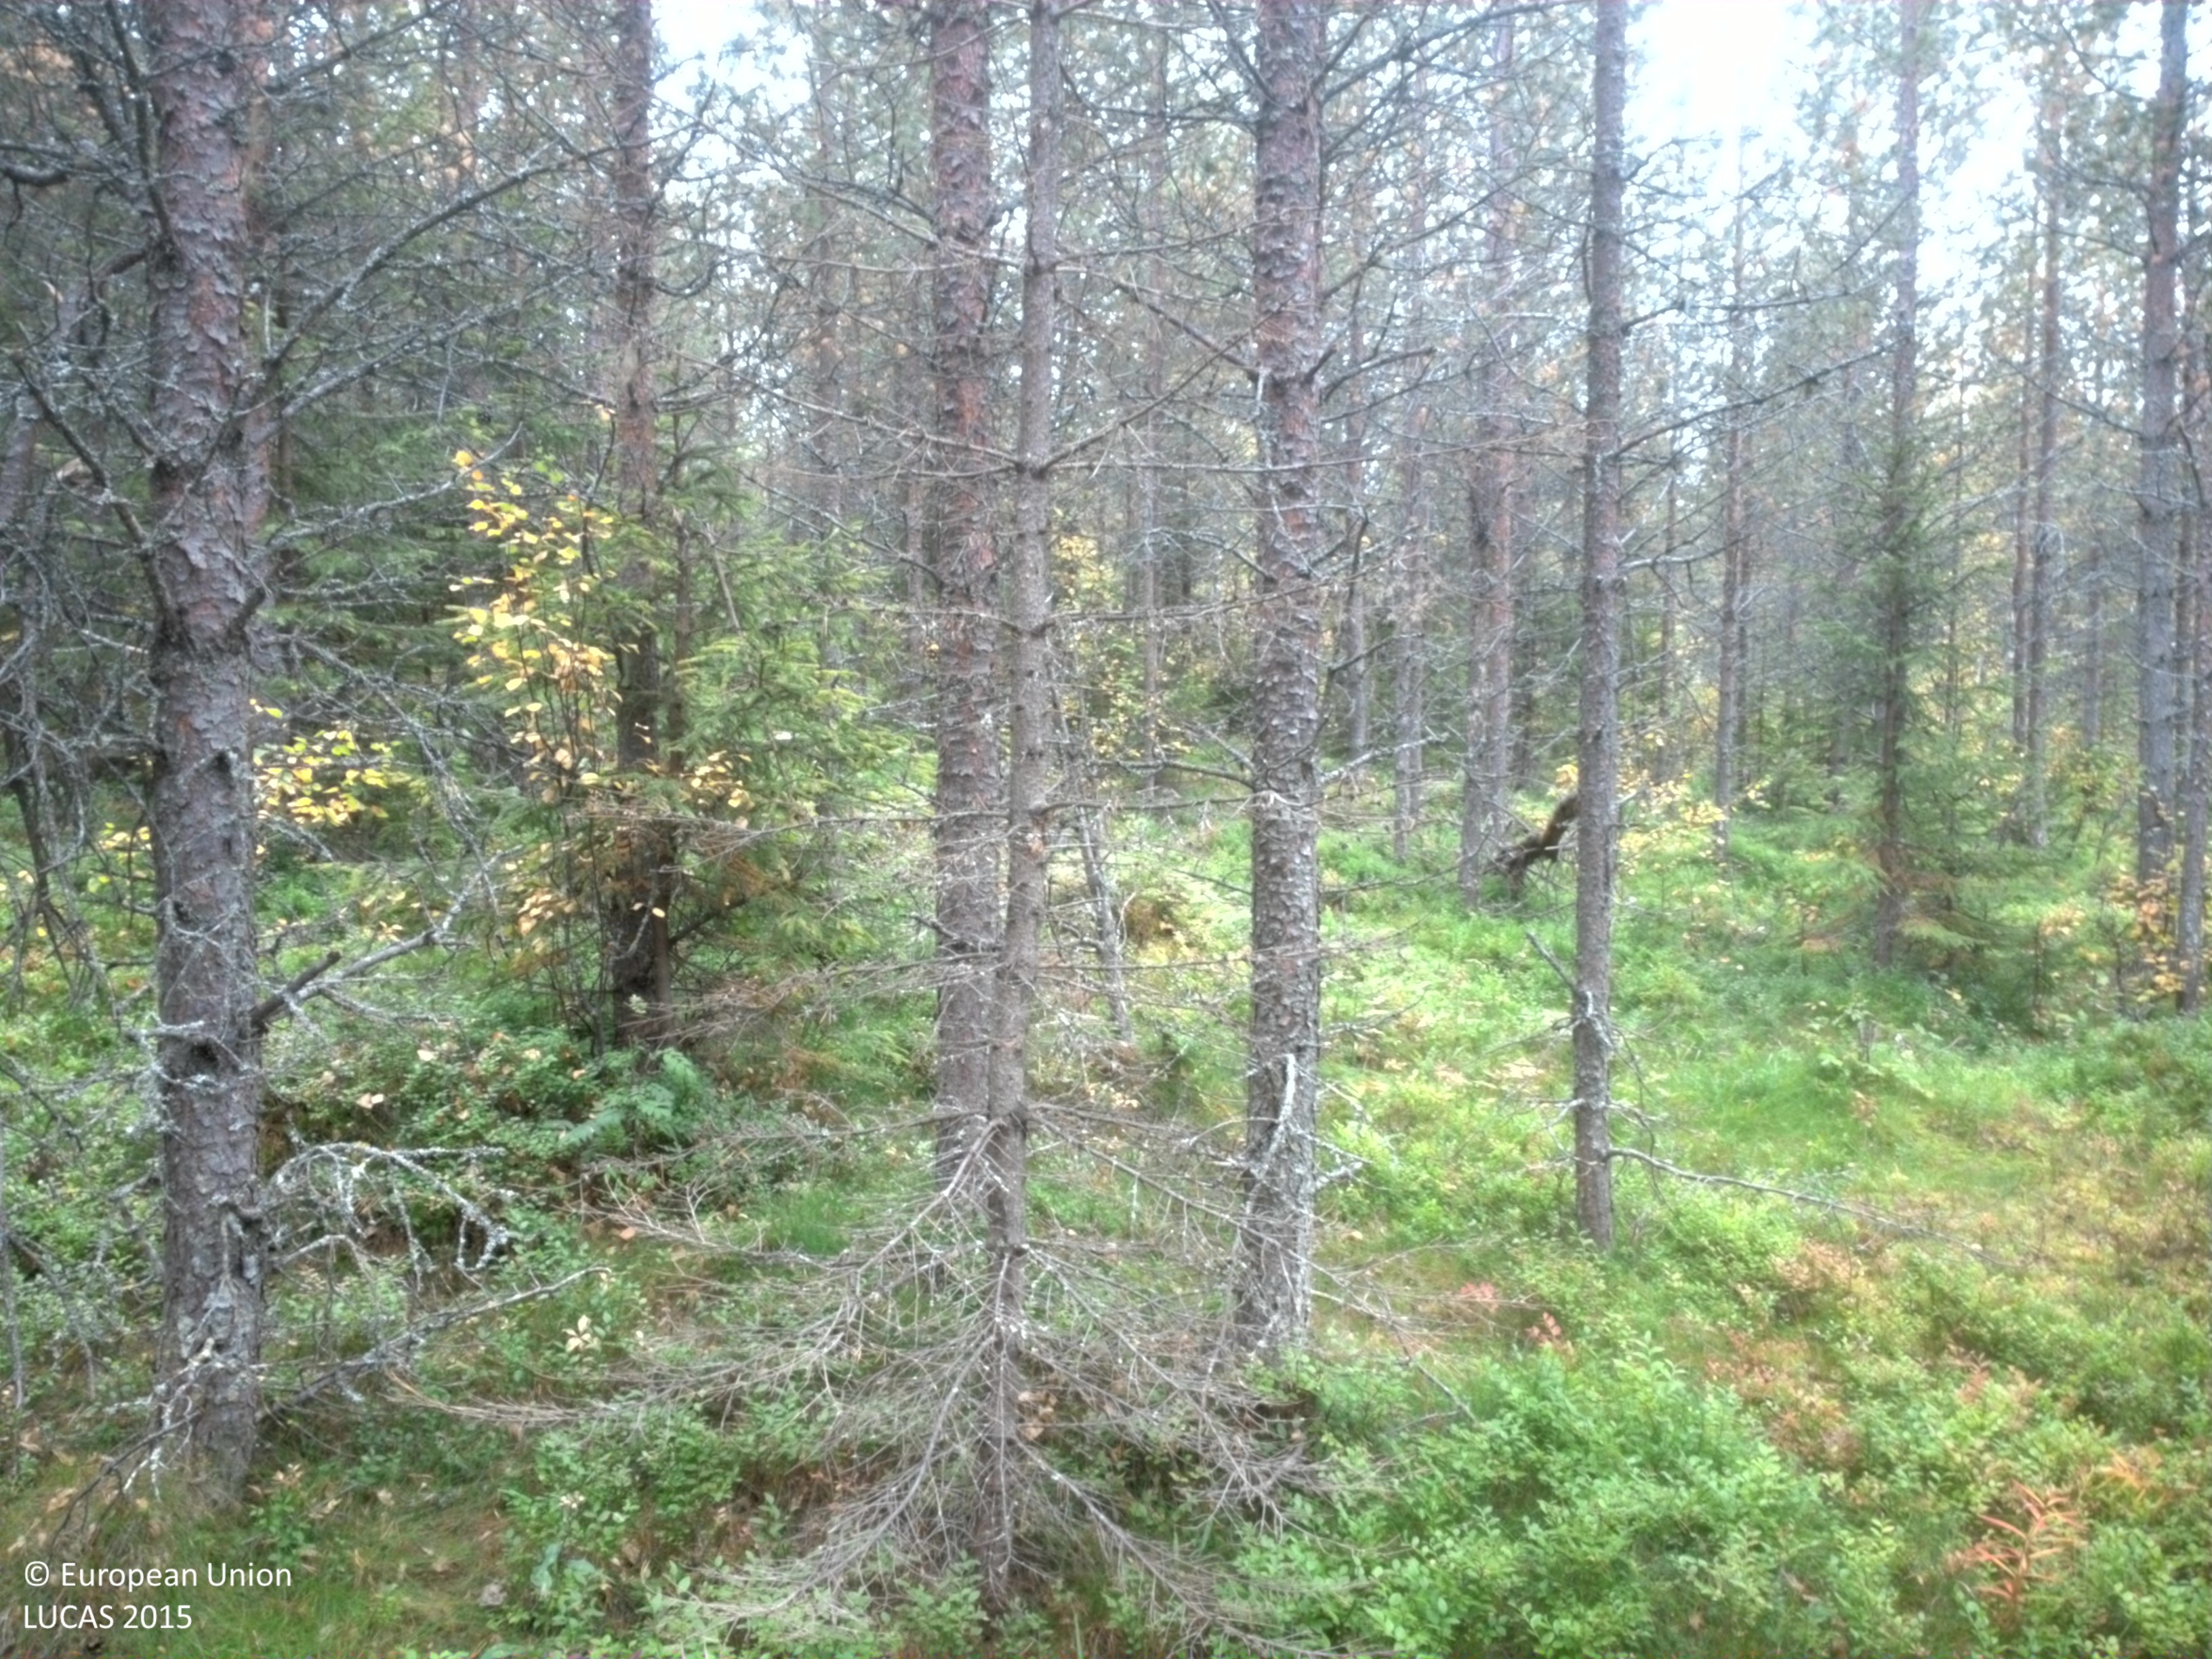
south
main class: Woodland
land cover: Pine dominated coniferous woodland
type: boreal forest
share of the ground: 50 - 75 %
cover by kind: coniferous forest trees 60 %, shrubs 20 %, herbaceous plants 10 %, broadleaved forest trees 5 %, lichens and mosses 5 %
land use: Forestry
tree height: > 5 m
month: September
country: SE
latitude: 64.4302
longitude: 20.2552
